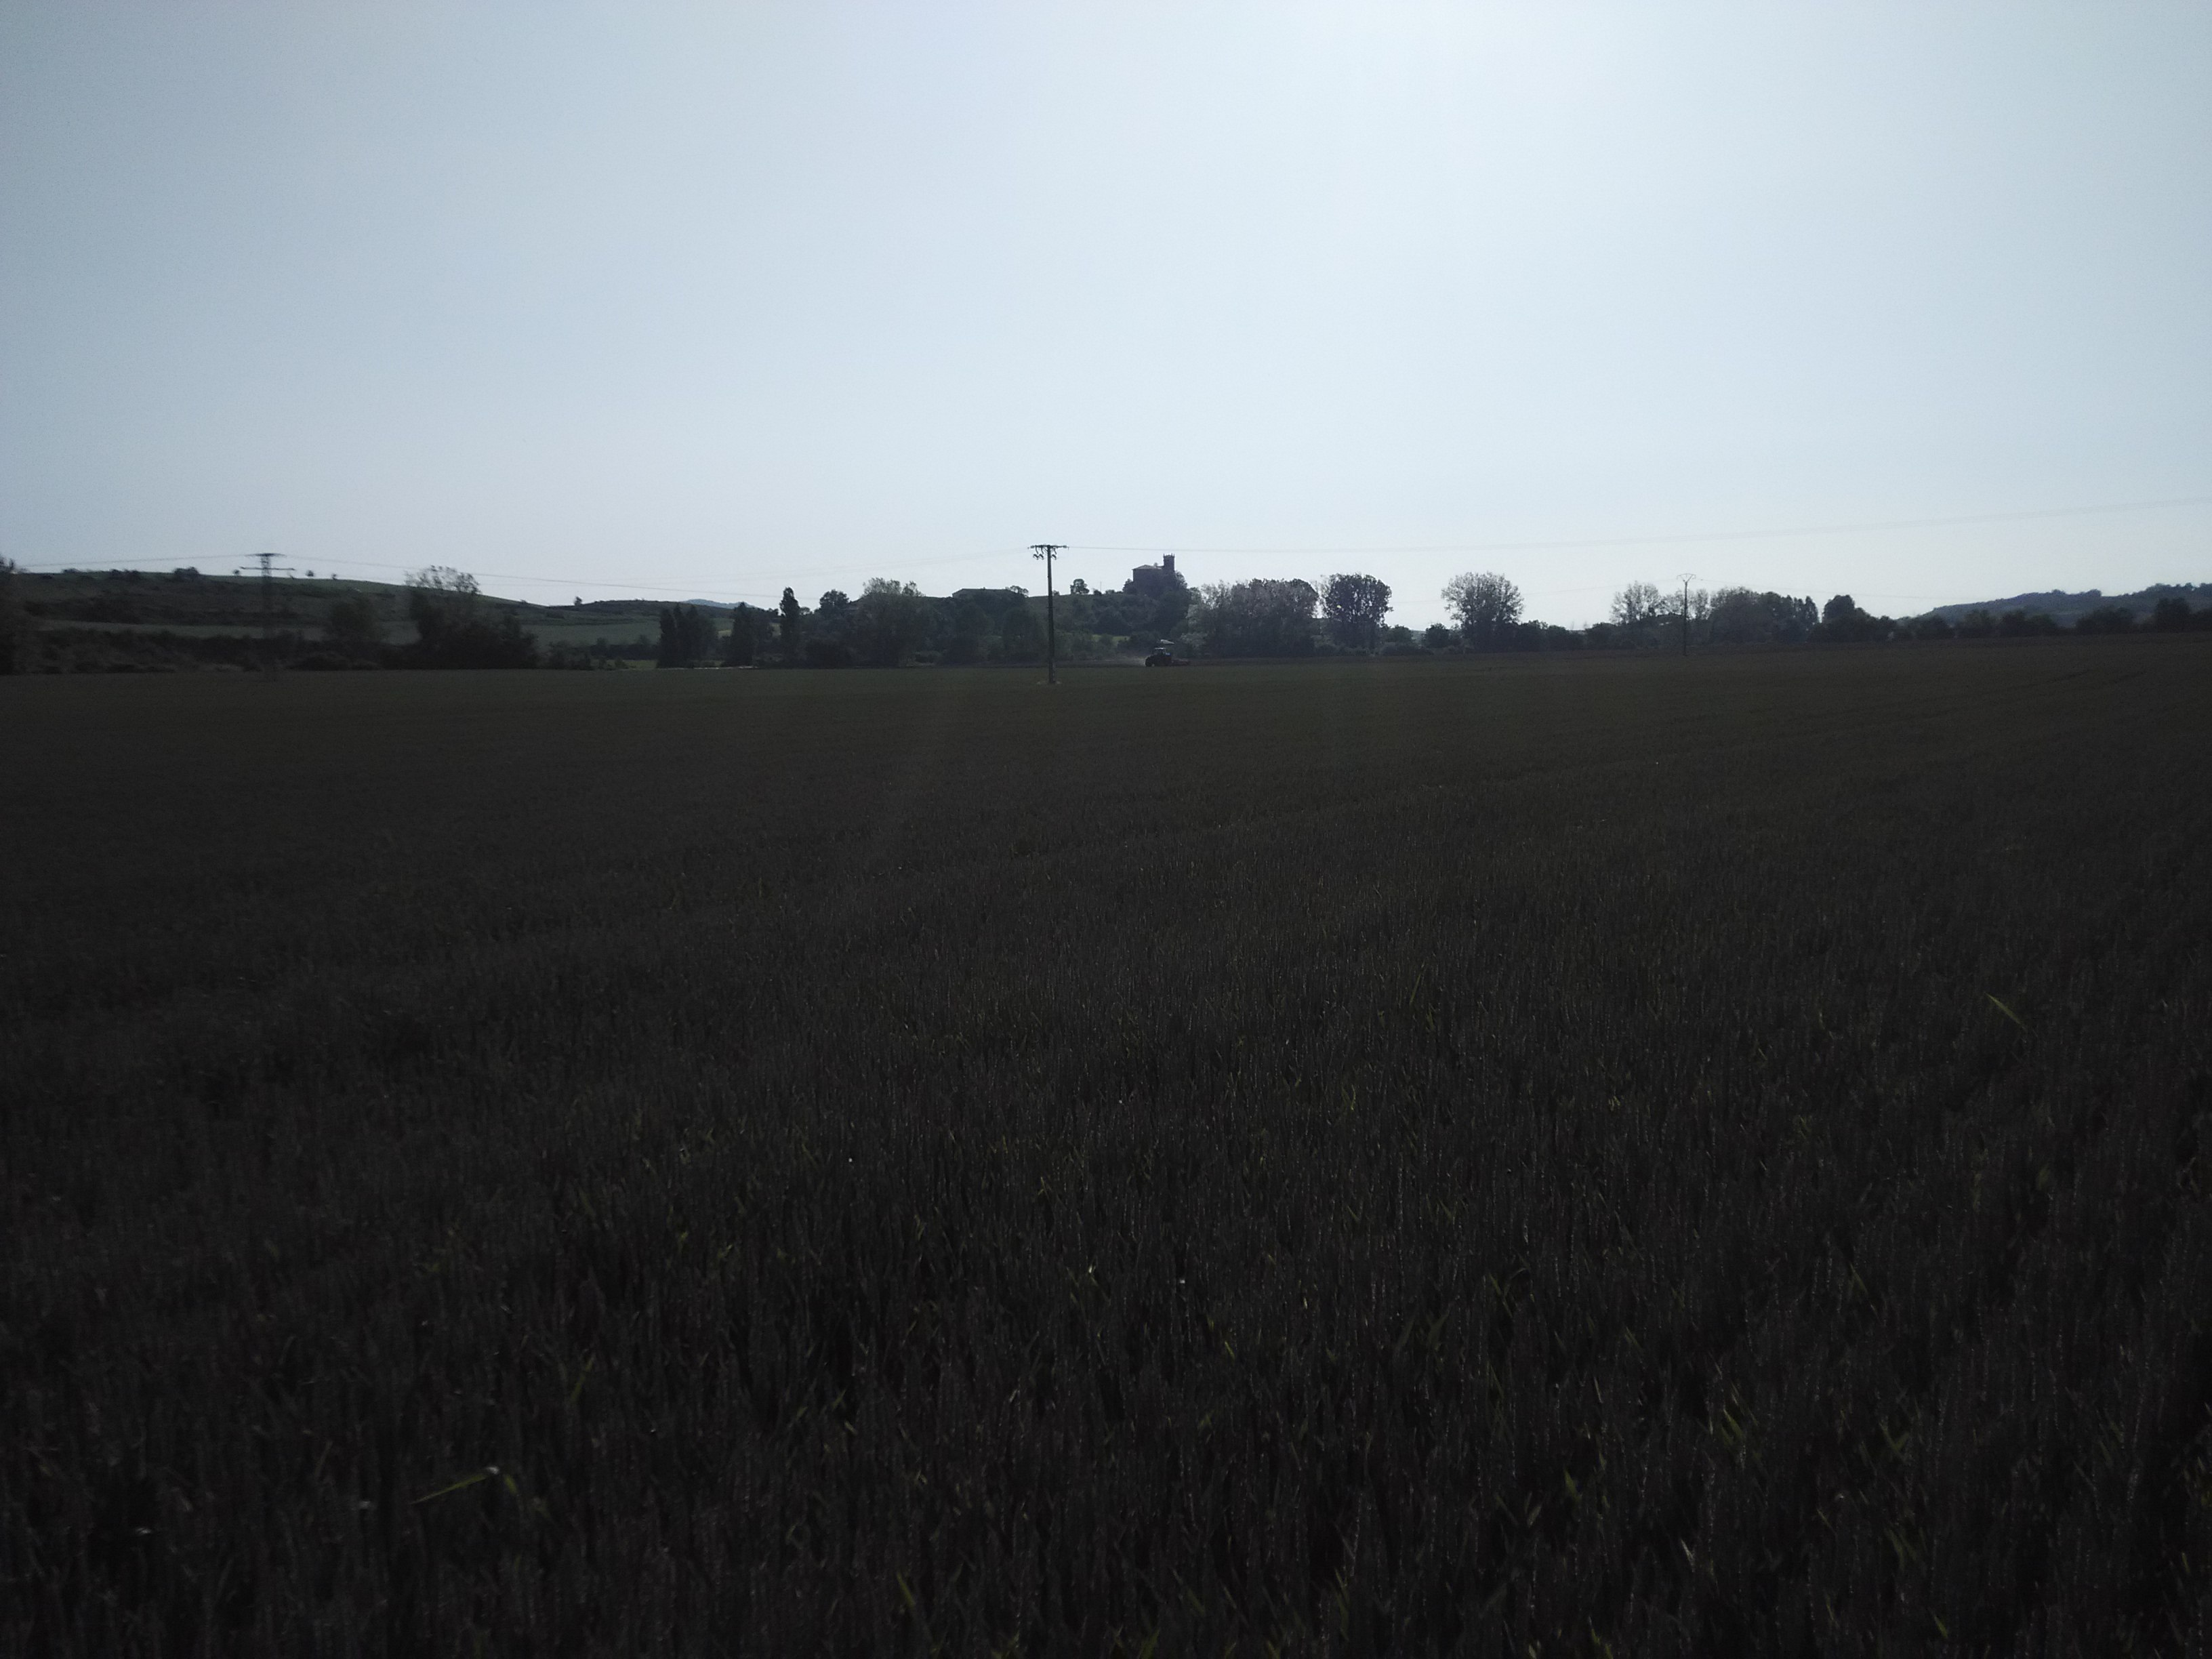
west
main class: Cropland
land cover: Common wheat
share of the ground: > 75 %
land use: Agriculture (excluding fallow land and kitchen gardens)
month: June
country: ES
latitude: 42.8830
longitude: -2.4763
